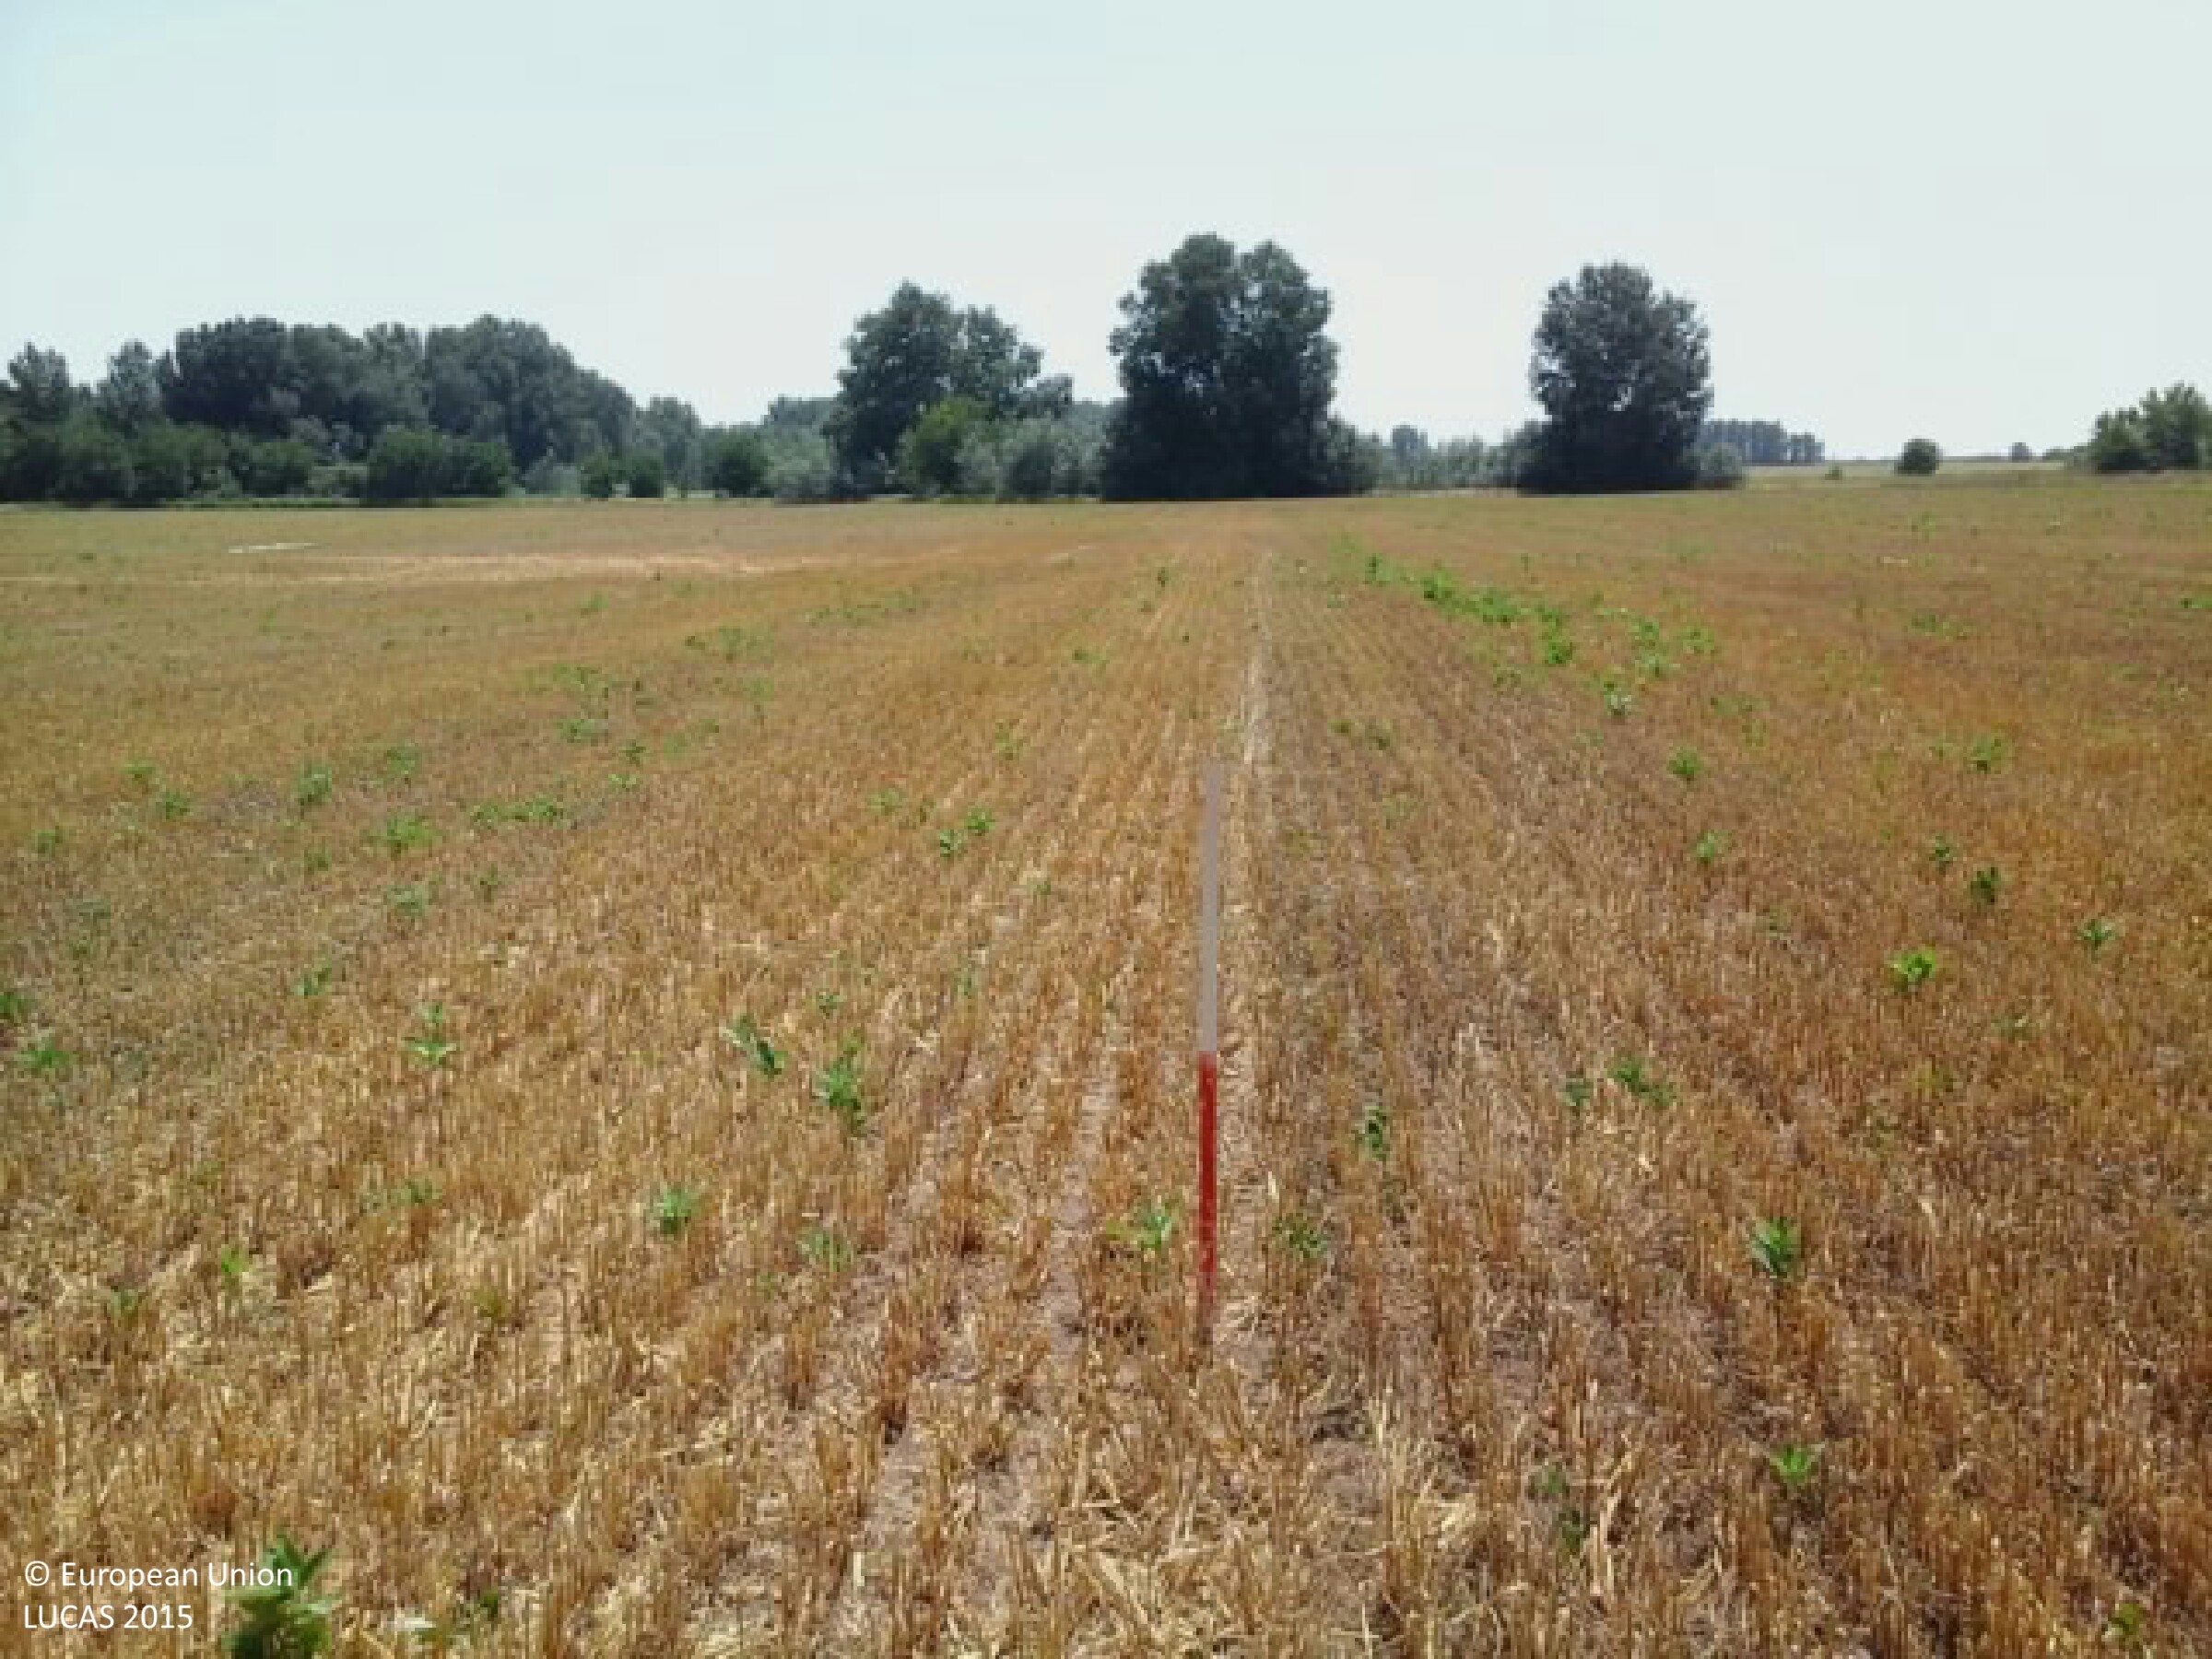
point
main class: Cropland
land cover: Barley
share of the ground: 25 - 50 %
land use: Agriculture (excluding fallow land and kitchen gardens)
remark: Harvested field
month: July
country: HU
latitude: 46.0778
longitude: 19.4415
